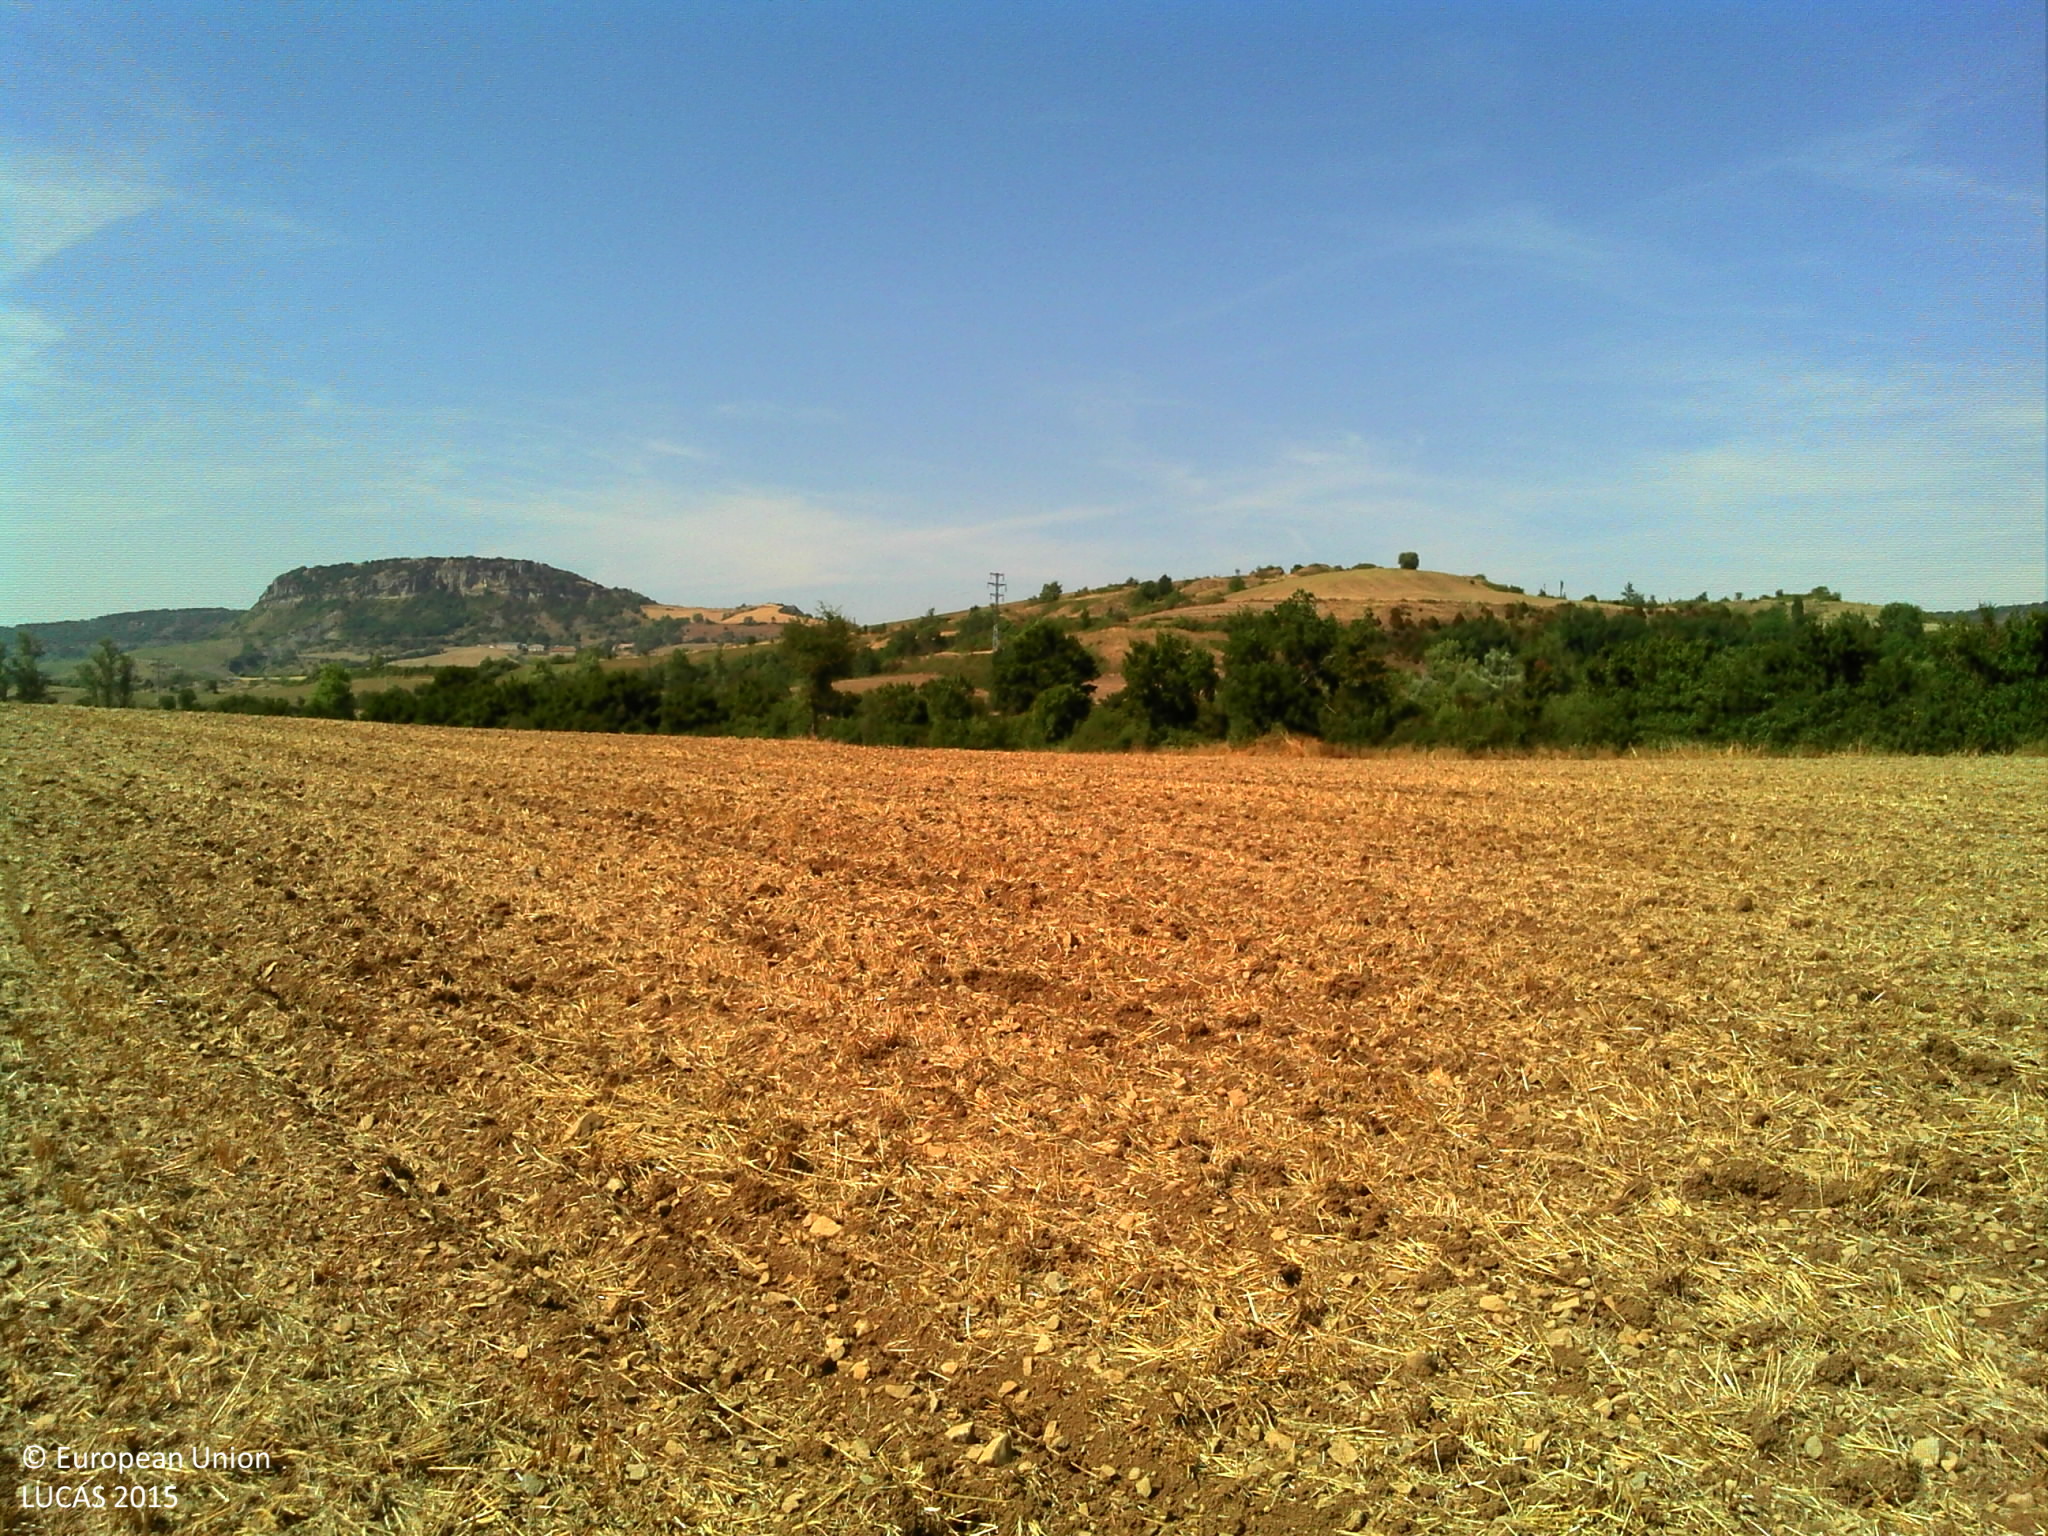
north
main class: Cropland
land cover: Barley
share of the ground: > 75 %
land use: Agriculture (excluding fallow land and kitchen gardens)
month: August
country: FR
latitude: 43.9342
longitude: 3.0180
